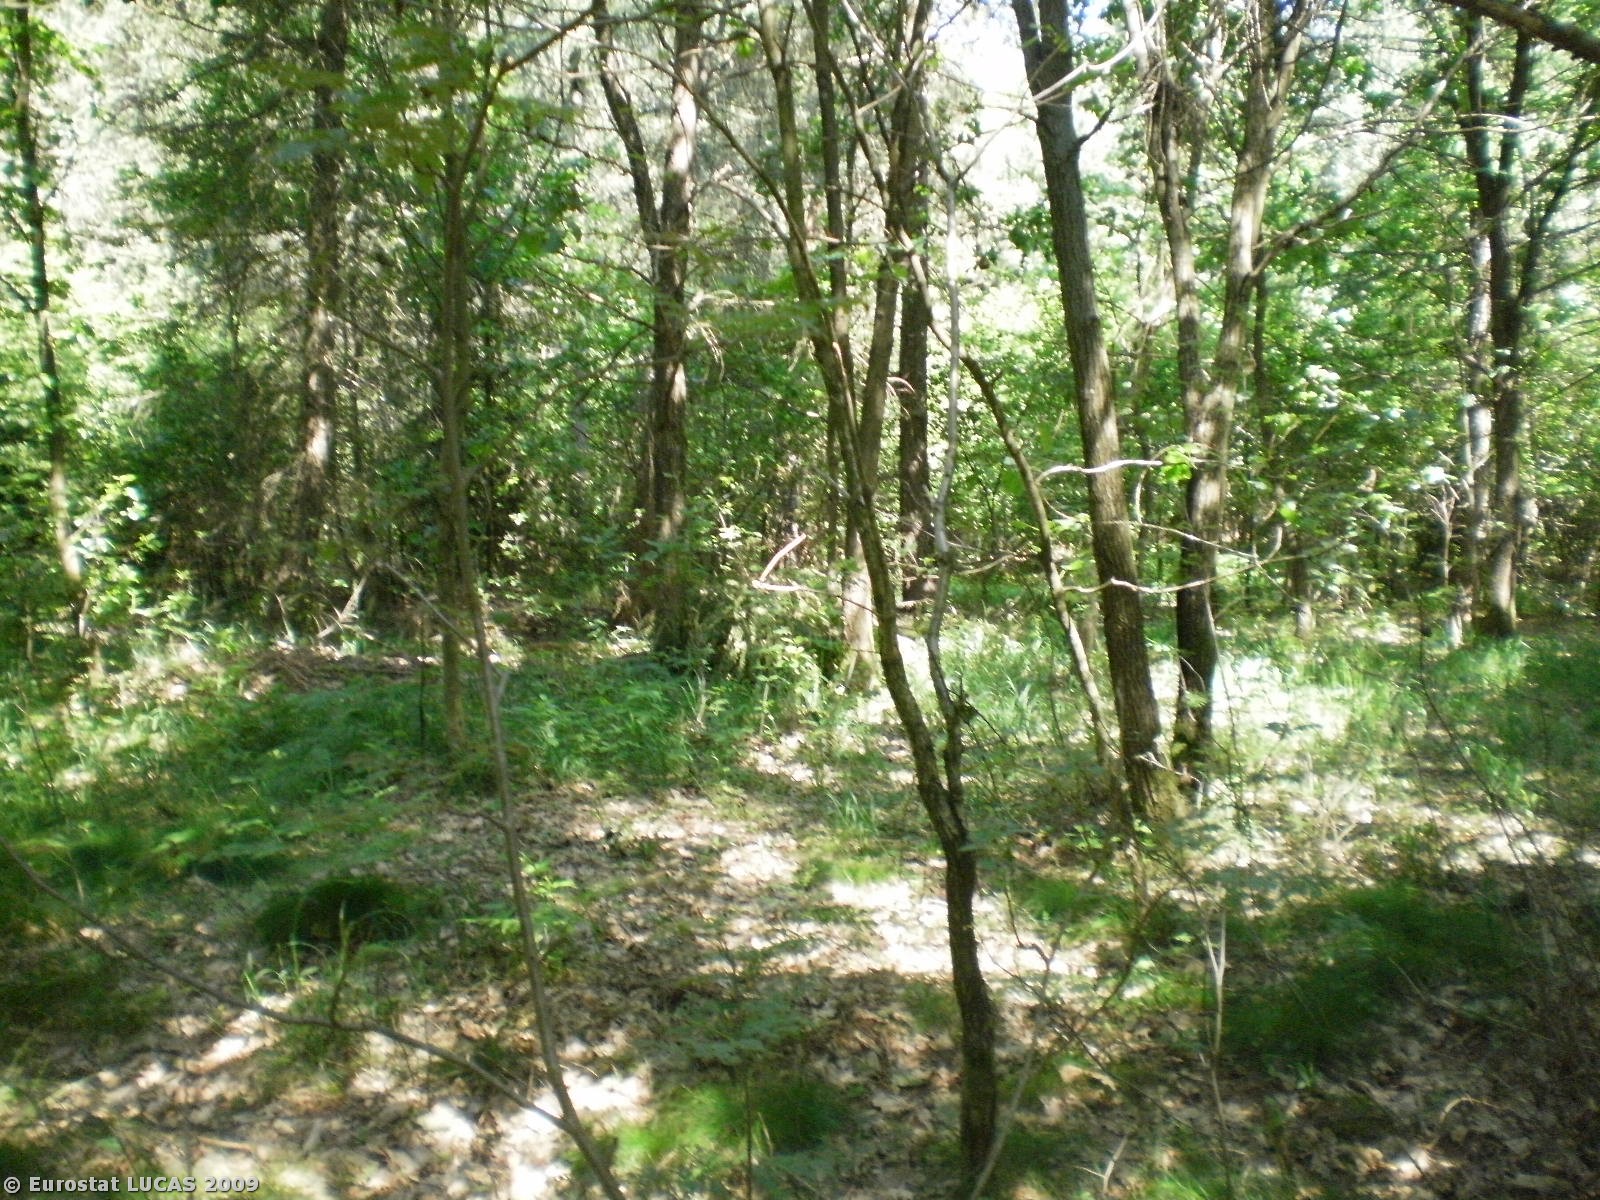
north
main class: Woodland
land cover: Mixed woodland
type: hemiboreal forest and nemoral coniferous forest and mixed broadleaved-coniferous forest
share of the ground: > 75 %
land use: Forestry
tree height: > 5 m
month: June
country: PL
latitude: 54.4628
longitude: 17.3066
